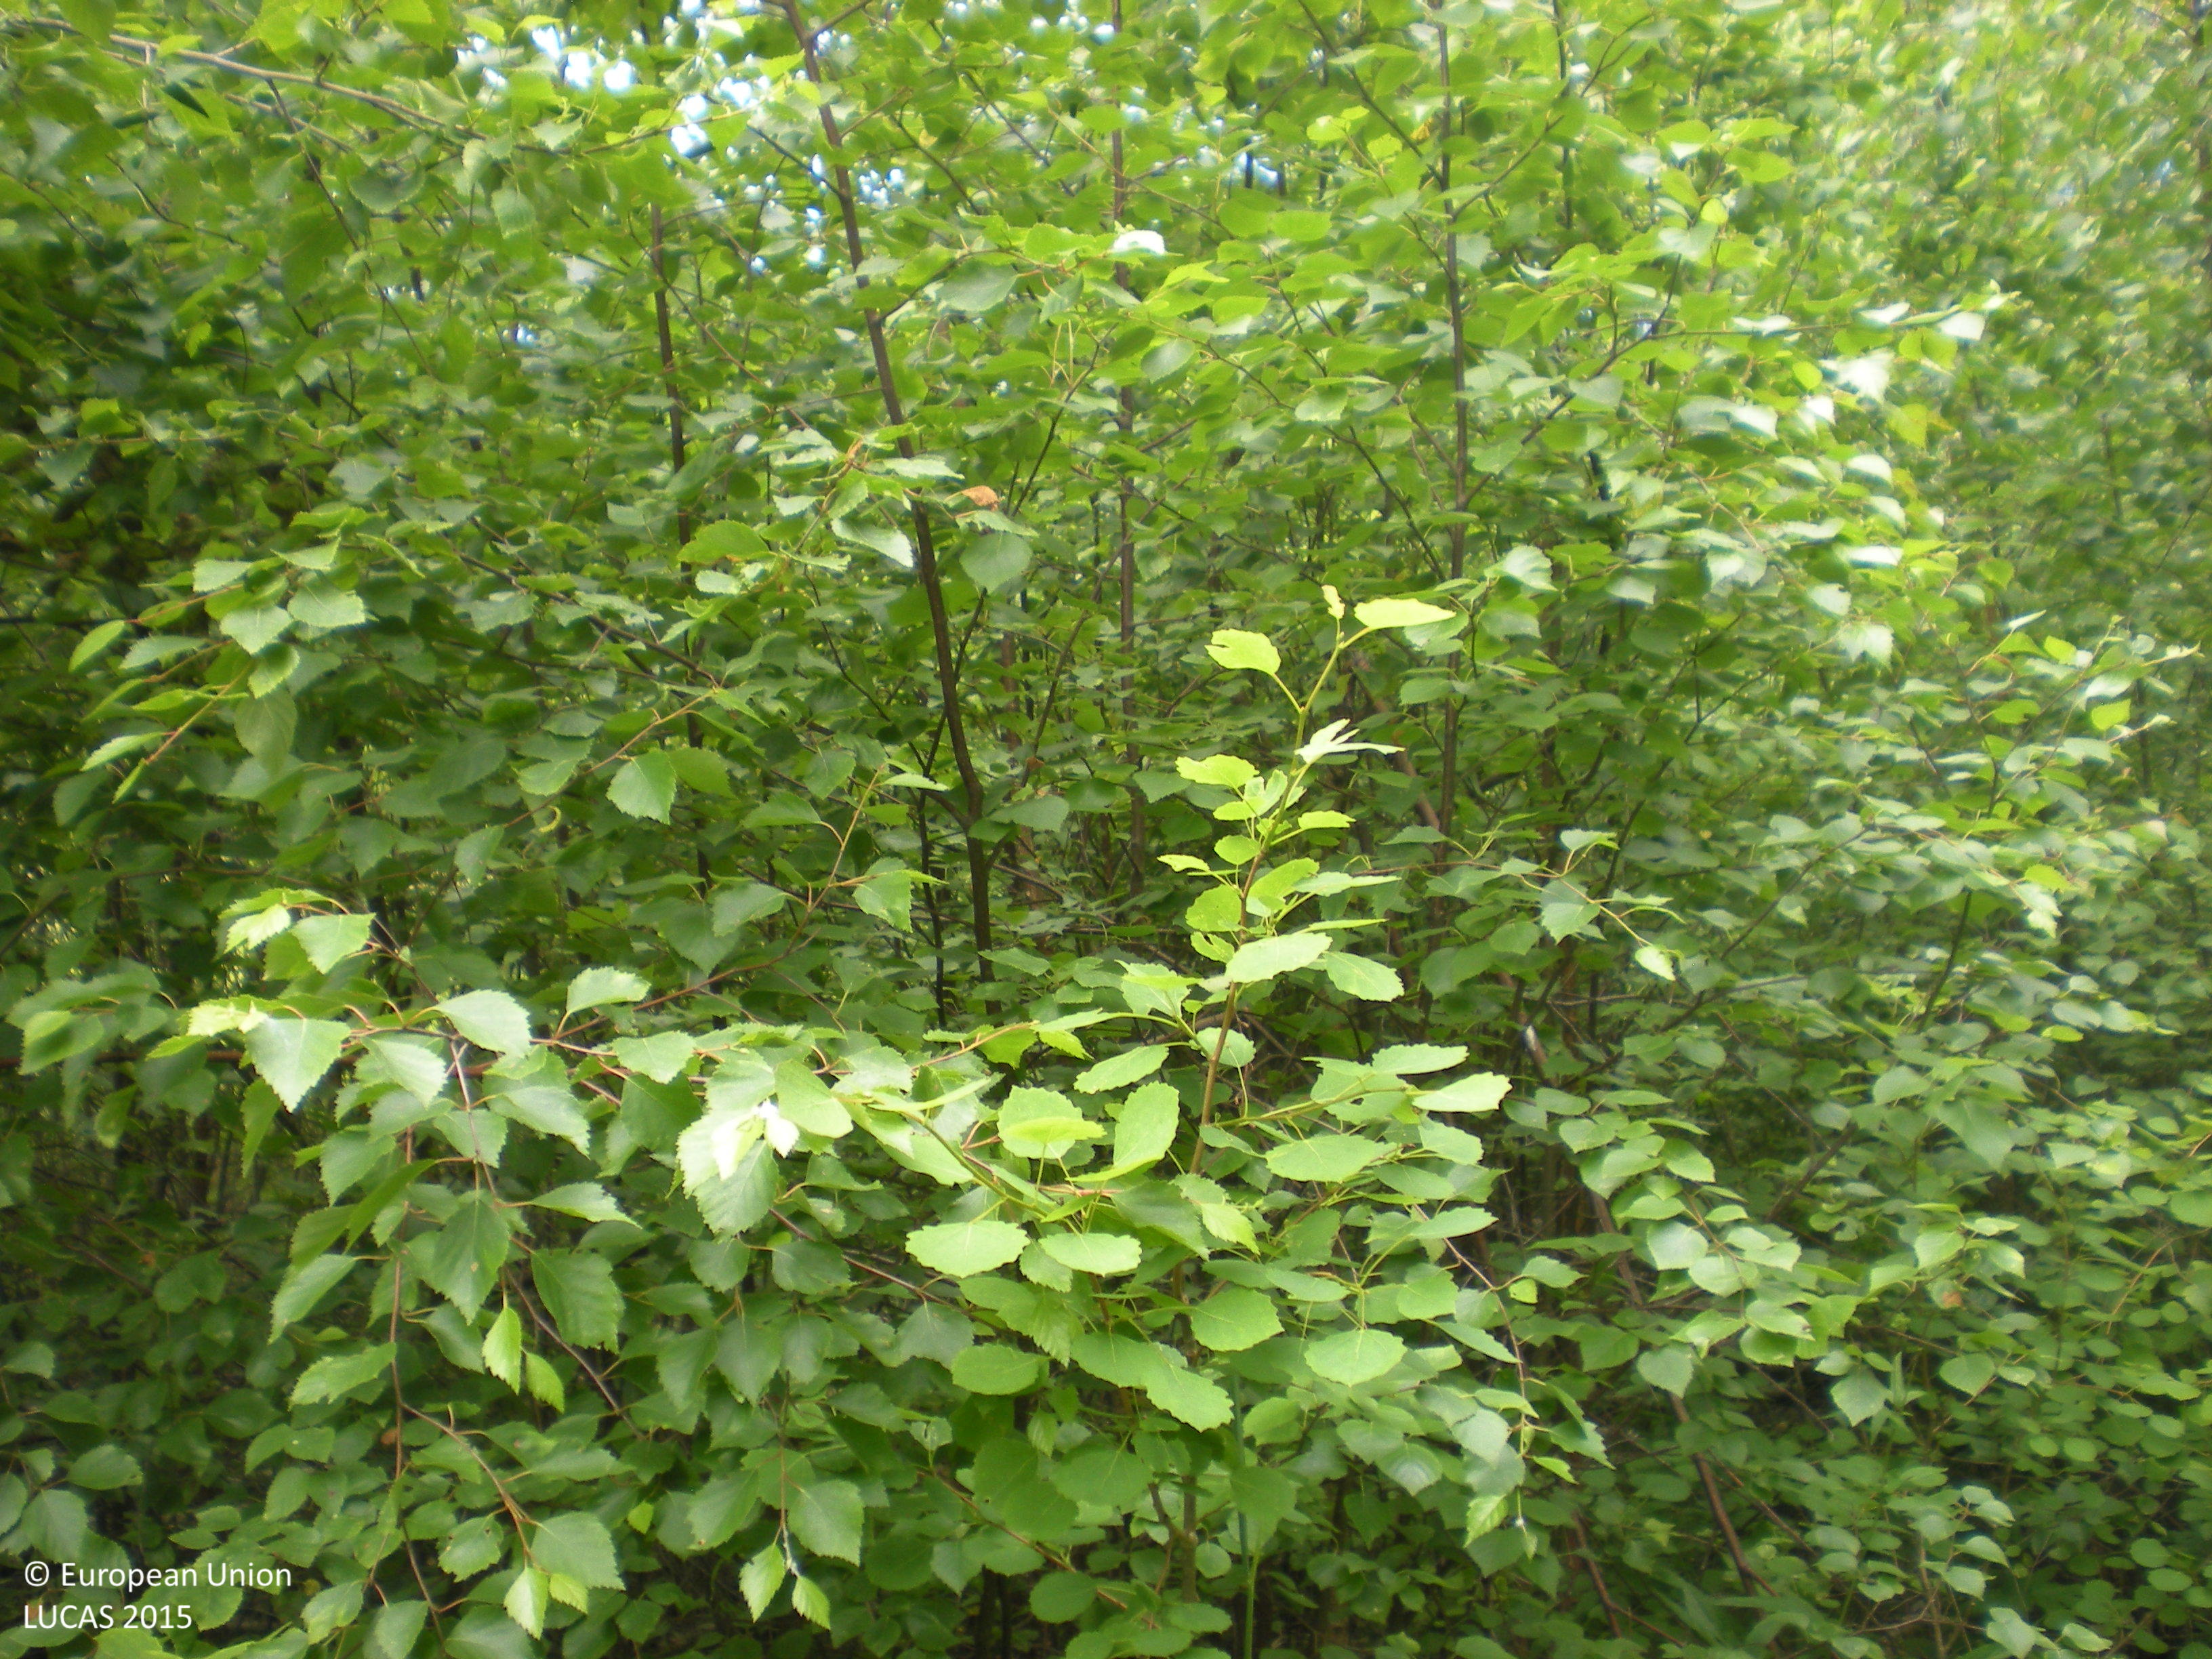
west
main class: Woodland
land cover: Broadleaved woodland
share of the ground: 50 - 75 %
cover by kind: broadleaved forest trees 65 %, herbaceous plants 15 %, shrubs 10 %, lichens and mosses 5 %
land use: Forestry
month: July
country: SE
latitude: 60.5551
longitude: 17.9250
